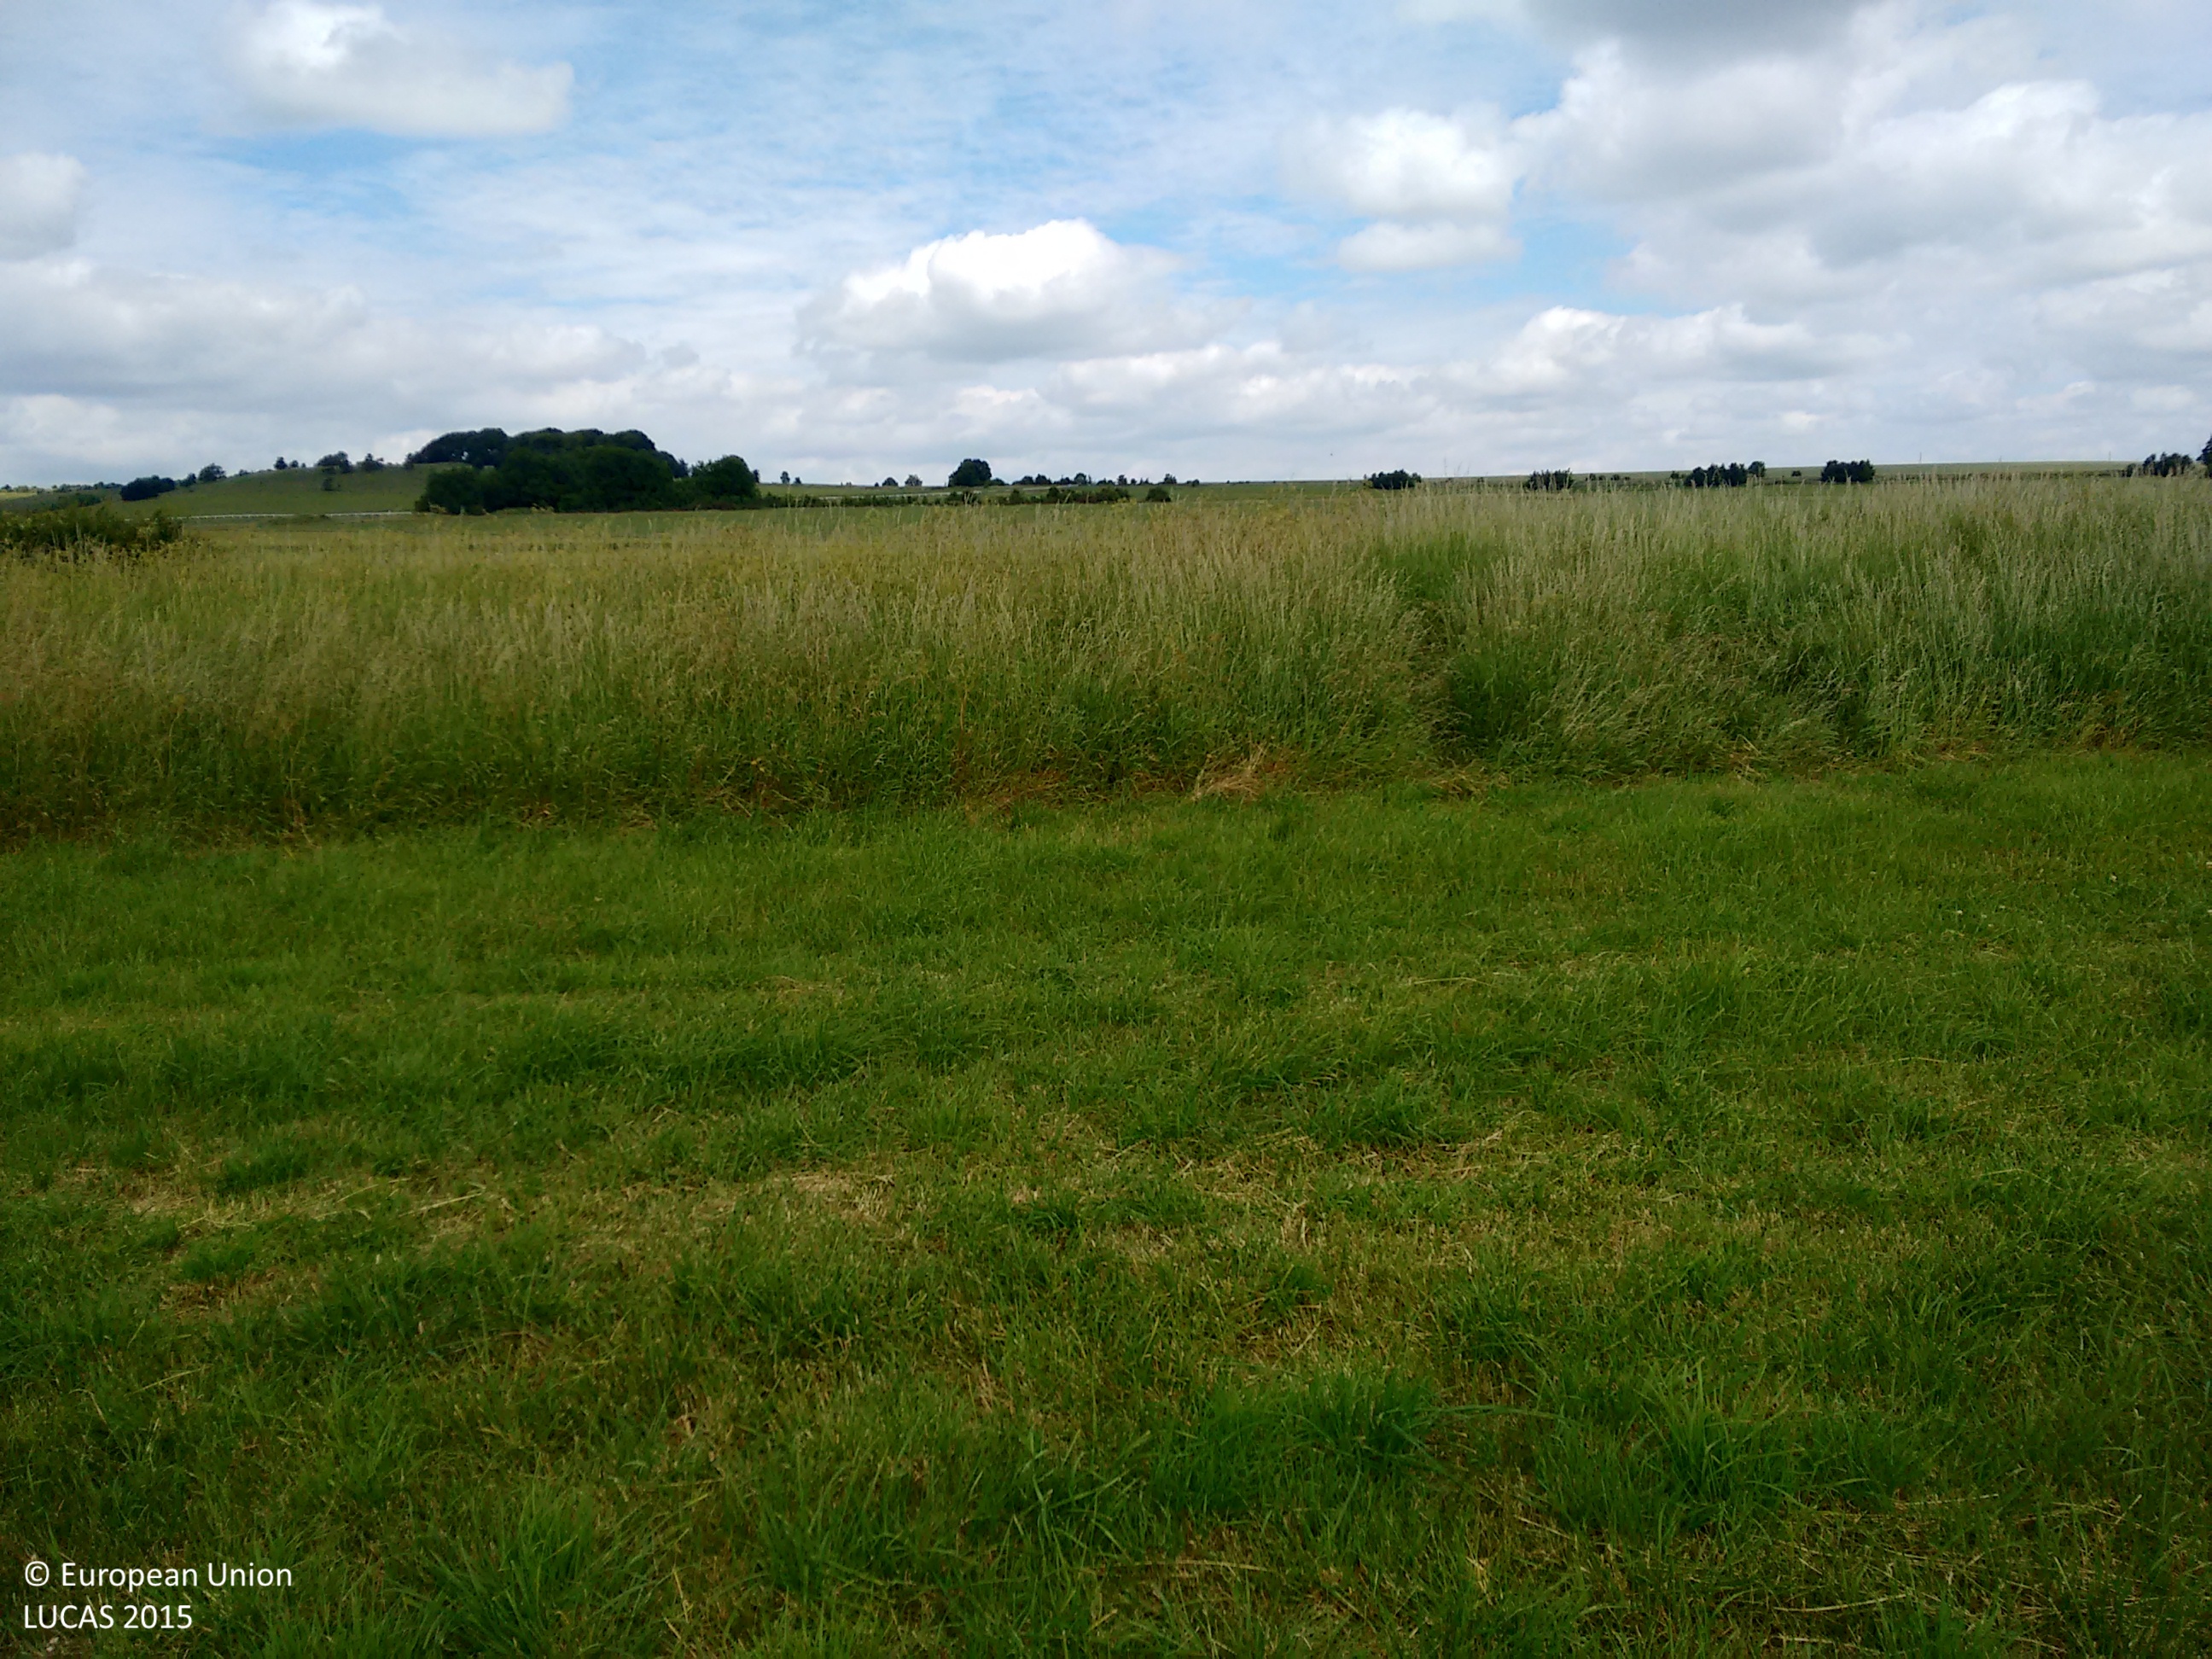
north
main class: Cropland
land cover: Rape and turnip rape
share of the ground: > 75 %
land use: Agriculture (excluding fallow land and kitchen gardens)
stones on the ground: 25 - 50 %
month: June
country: GB
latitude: 51.4138
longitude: -1.8902
